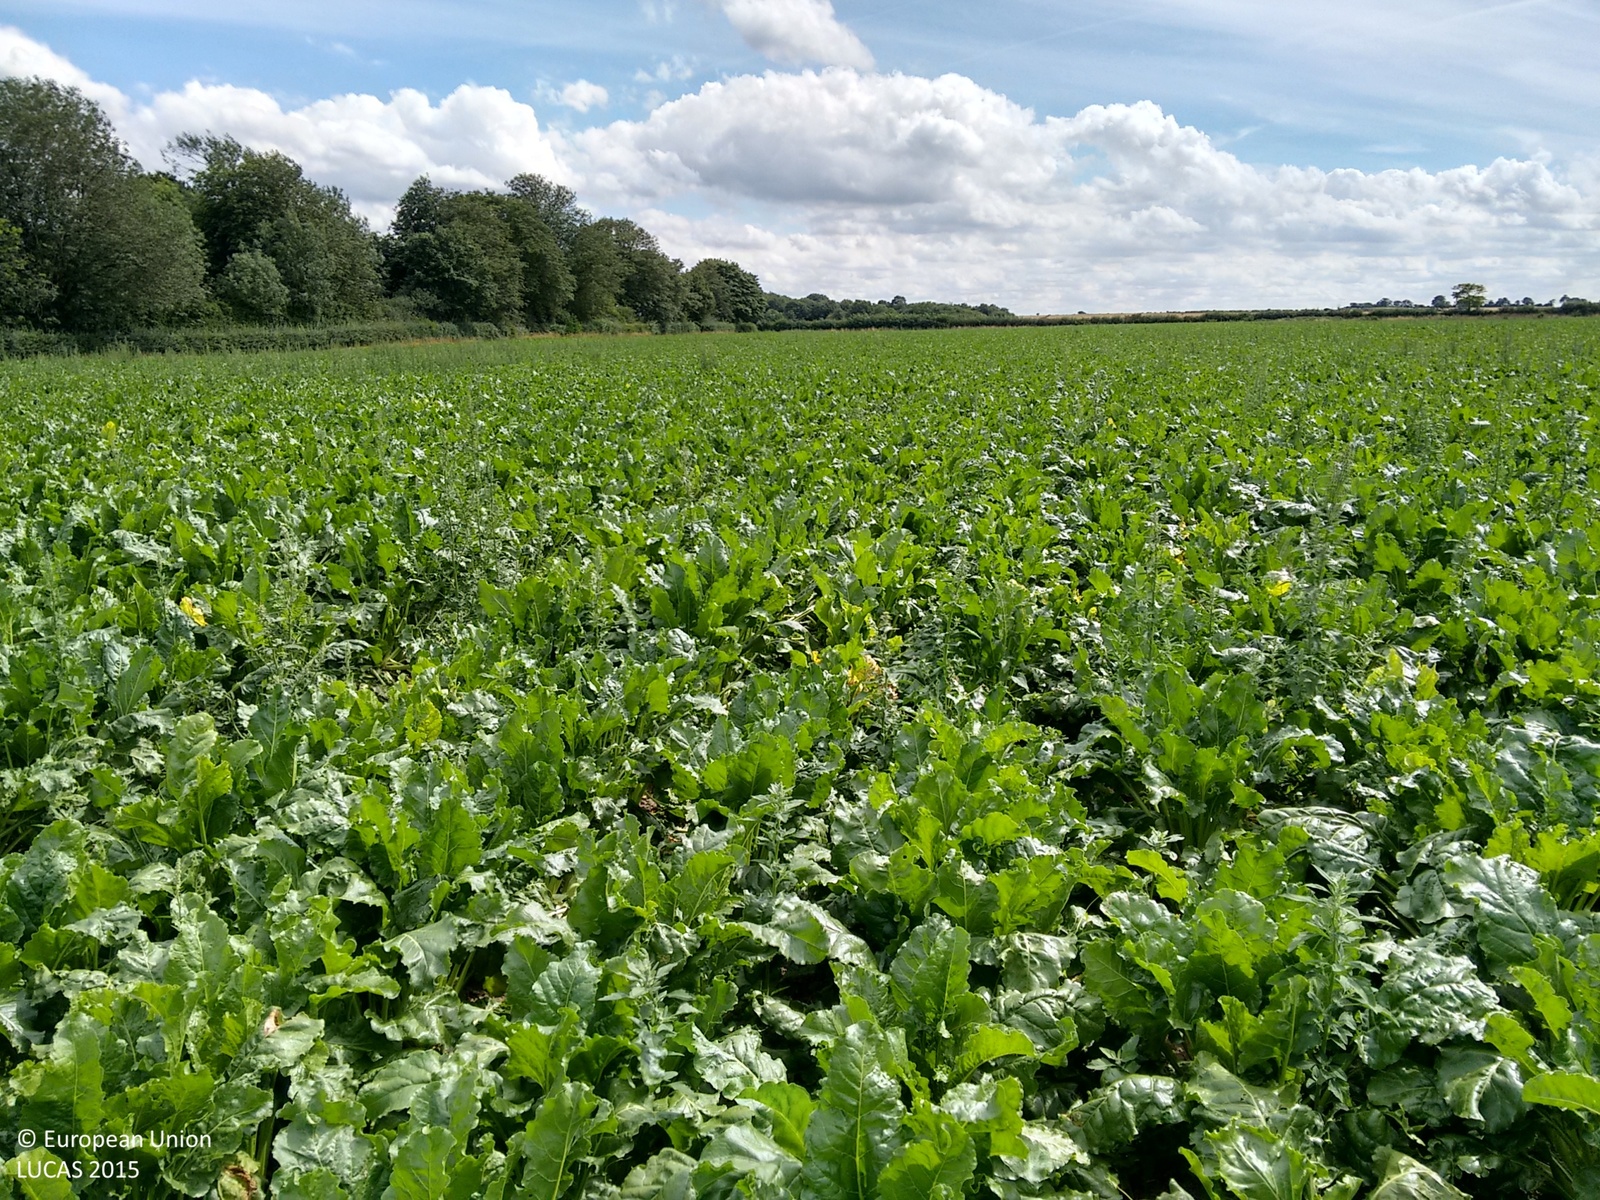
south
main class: Cropland
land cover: Sugar beet
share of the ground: > 75 %
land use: Agriculture (excluding fallow land and kitchen gardens)
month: August
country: GB
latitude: 52.4849
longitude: 0.5039
